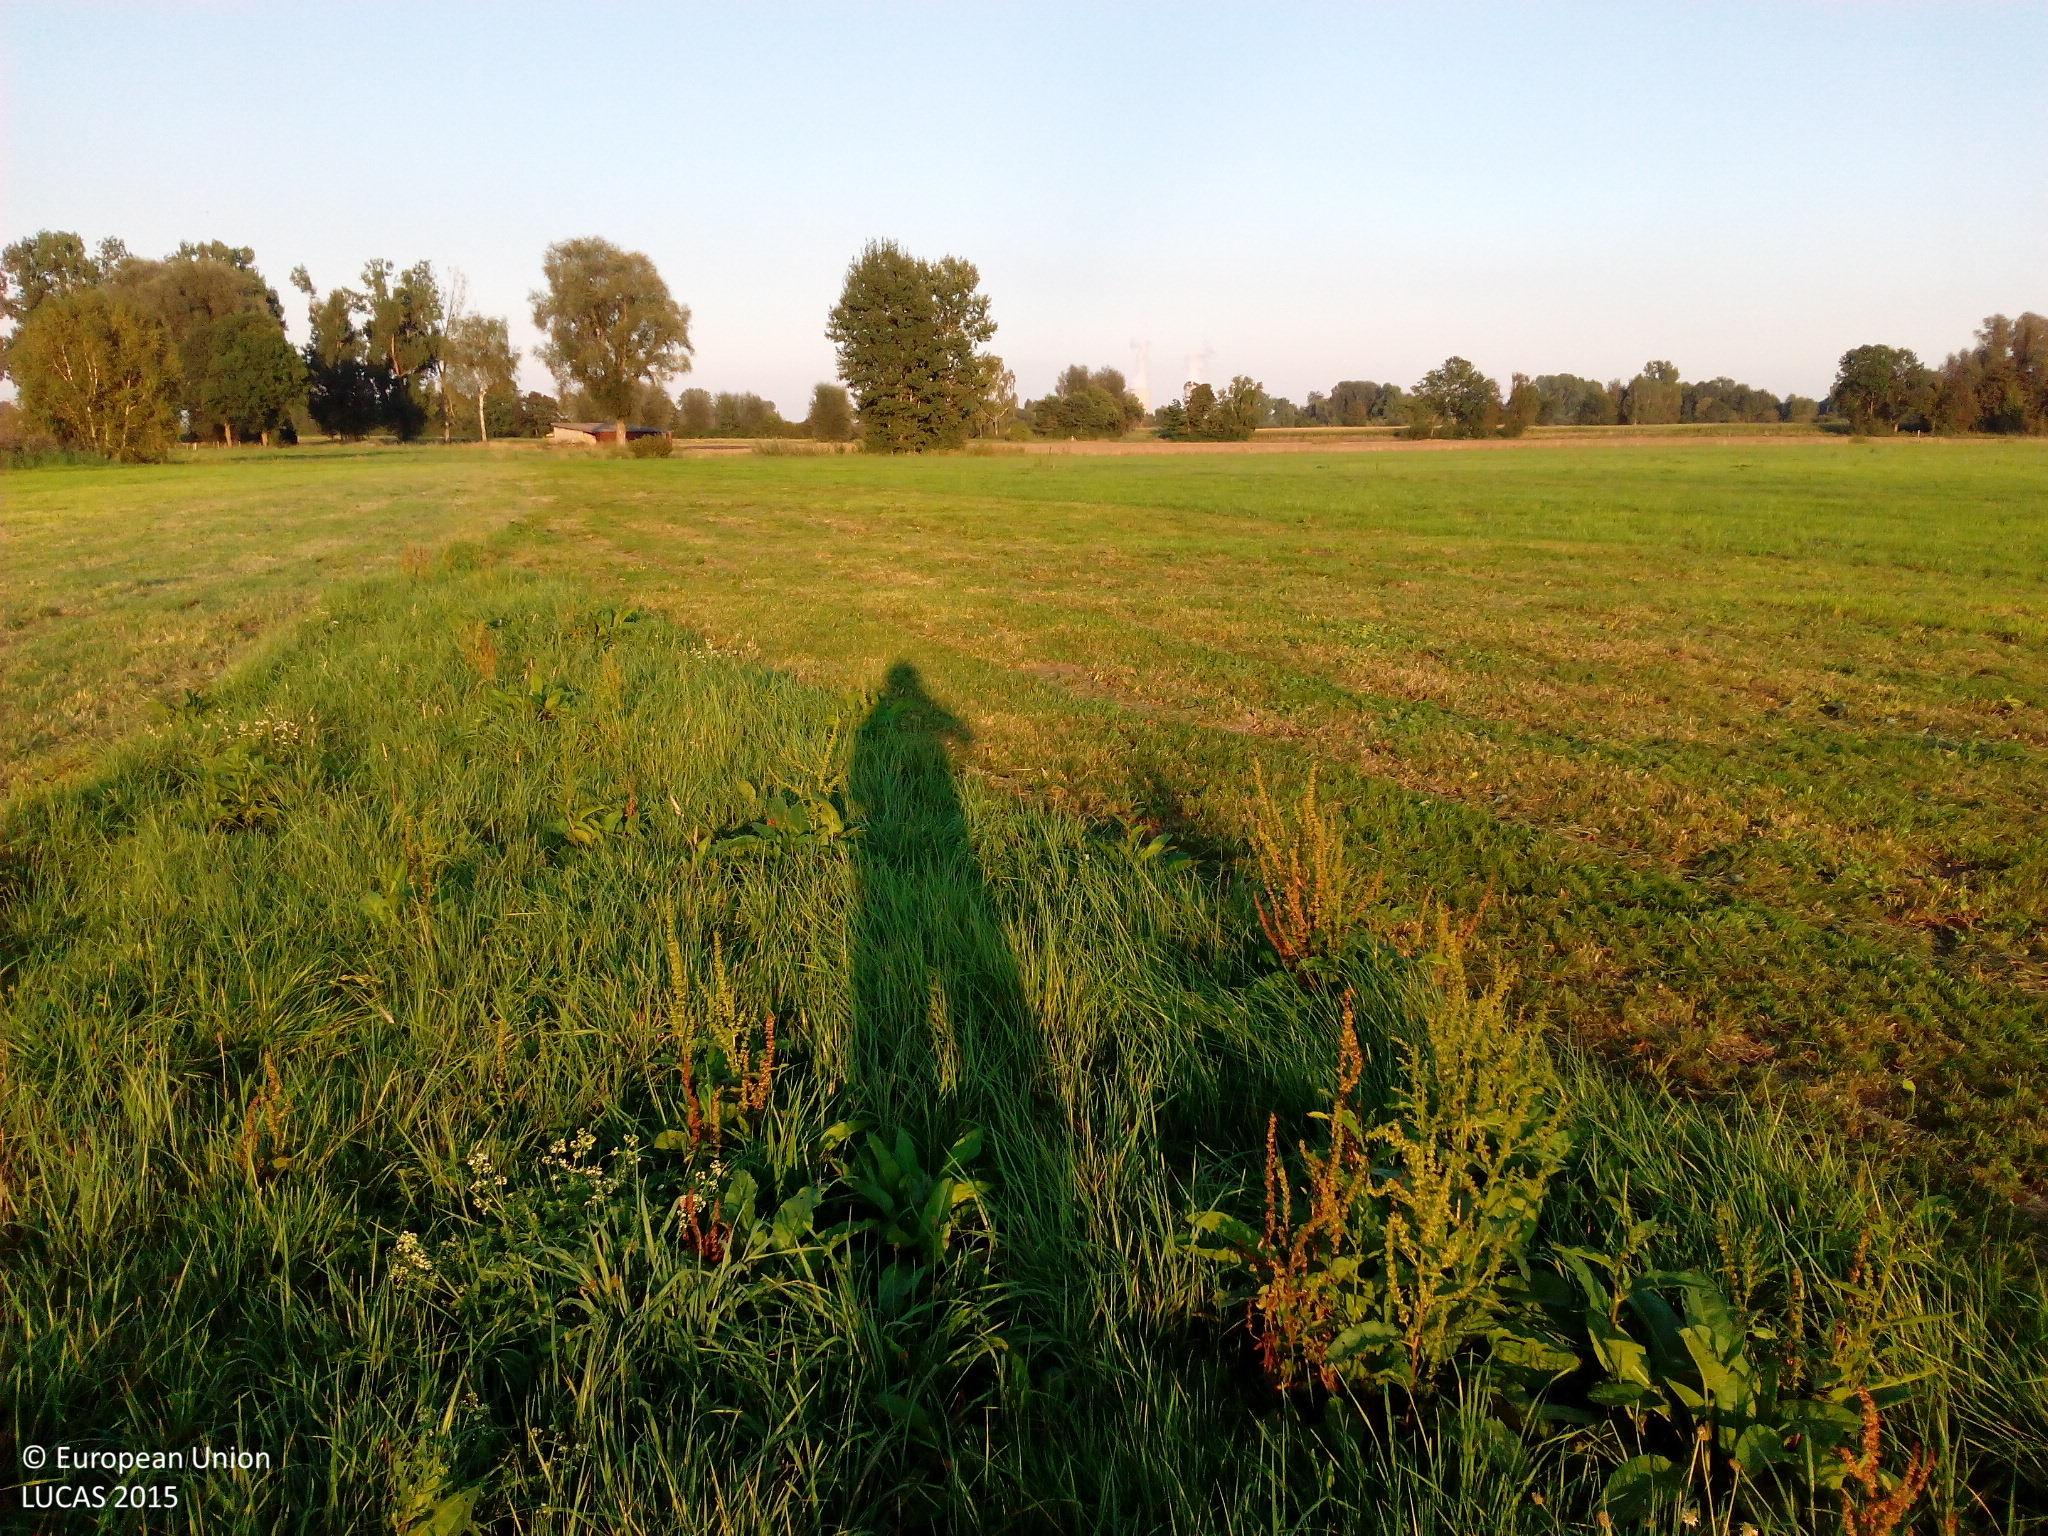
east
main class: Grassland
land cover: Grassland without tree/shrub cover
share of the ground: > 75 %
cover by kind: herbaceous plants 100 %
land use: Agriculture (excluding fallow land and kitchen gardens)
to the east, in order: Grassland without tree/shrub cover; Shruby margins; Ditches and canals; Grassland without tree/shrub cover; Shruby margins; Ditches and canals; Shruby margins; Tracks; Other bare soil
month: August
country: DE
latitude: 48.5290
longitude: 10.3113
